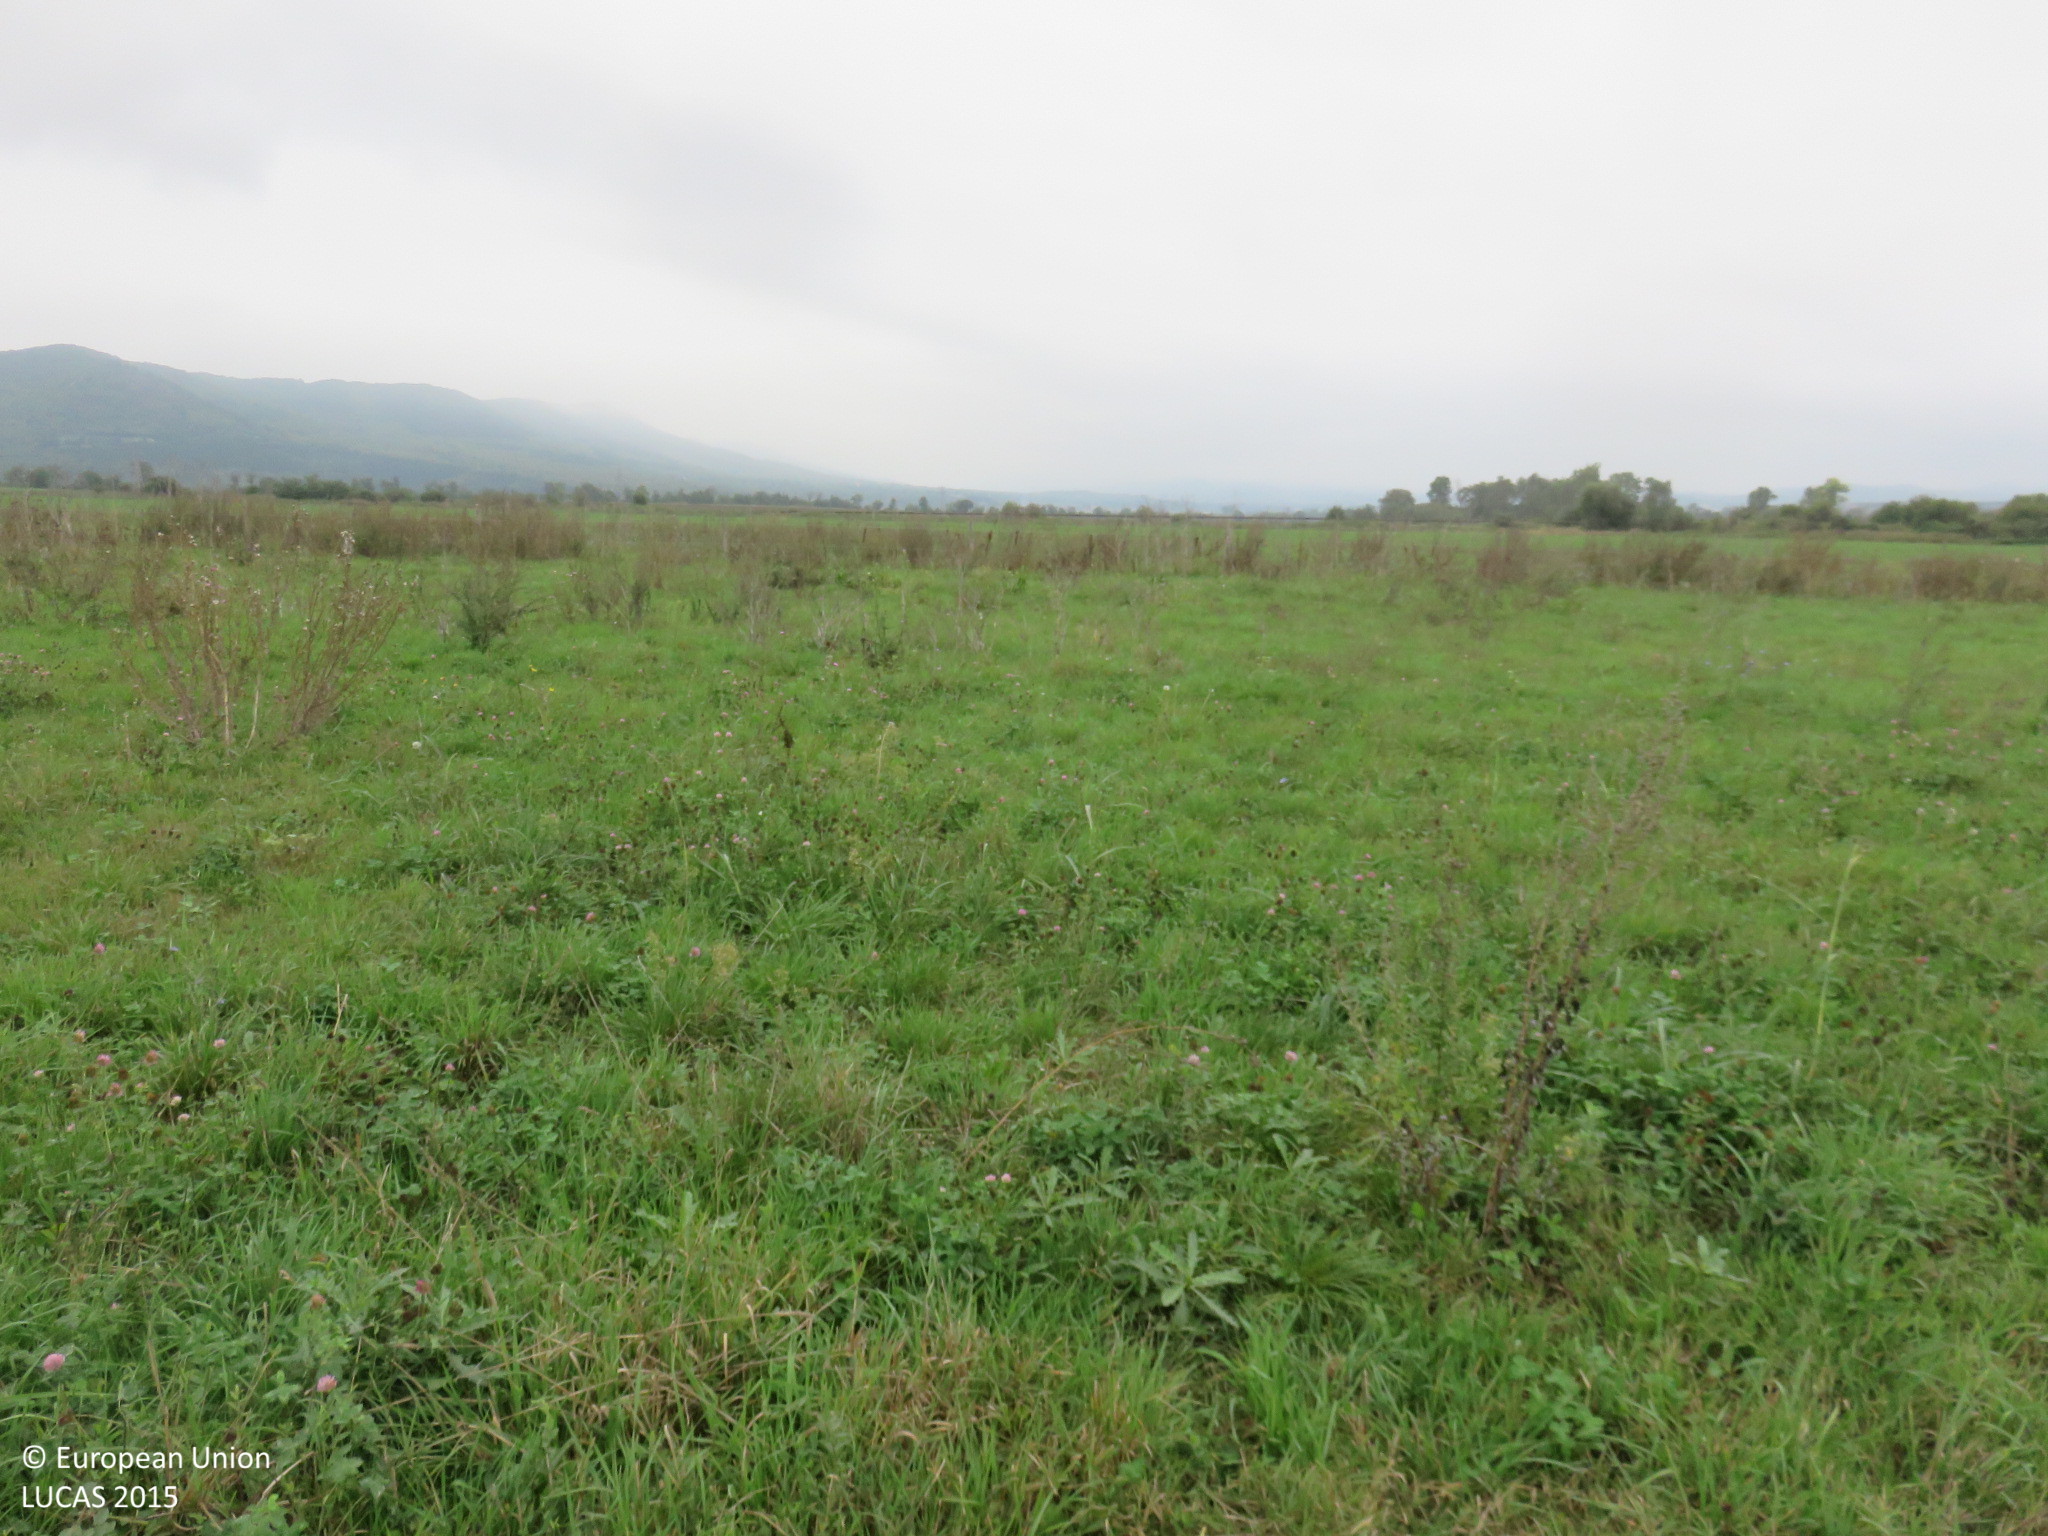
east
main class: Grassland
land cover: Grassland without tree/shrub cover
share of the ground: > 75 %
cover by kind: herbaceous plants 100 %
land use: Agriculture (excluding fallow land and kitchen gardens)
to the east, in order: Grassland without tree/shrub cover; Fences; Grassland without tree/shrub cover; Fences; Tracks; Other leguminous and mixtures for fodder
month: September
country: BG
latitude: 43.0466
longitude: 25.0314
